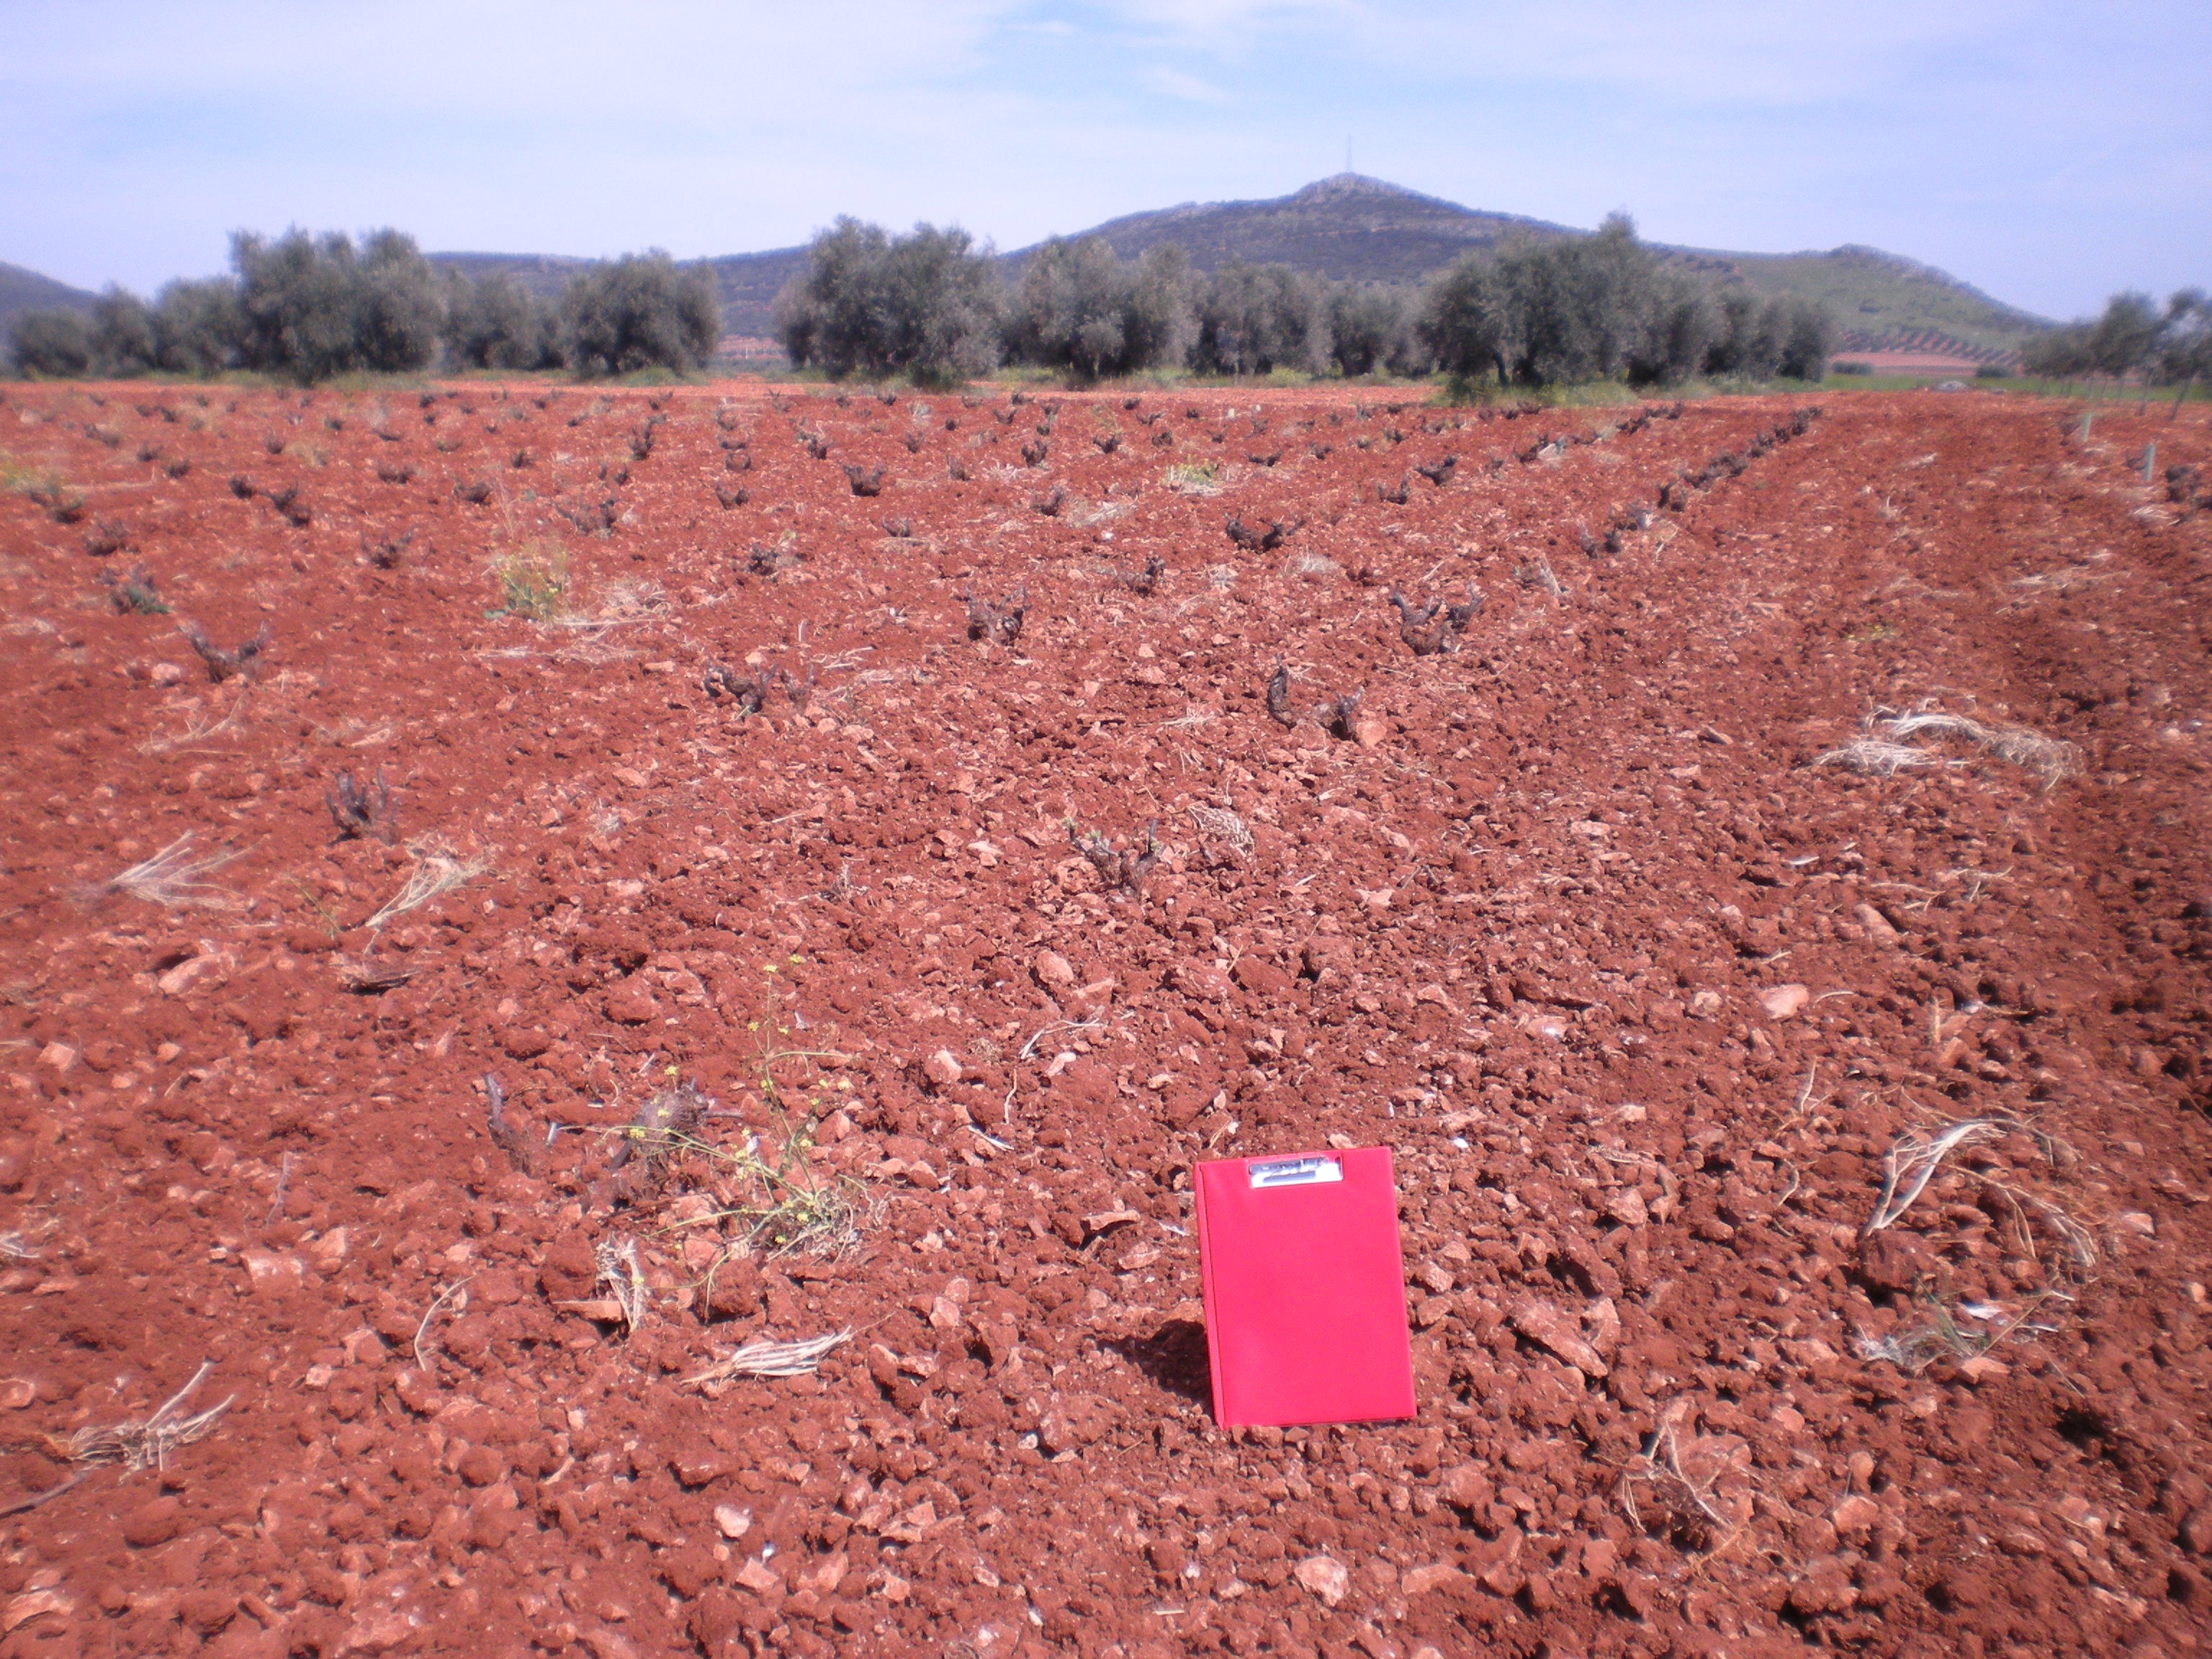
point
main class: Cropland
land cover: Vineyards
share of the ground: < 10 %
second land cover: Other bare soil
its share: > 75 %
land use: Agriculture (excluding fallow land and kitchen gardens)
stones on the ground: 10 - 25 %
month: April
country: ES
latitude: 38.8157
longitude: -3.2431
